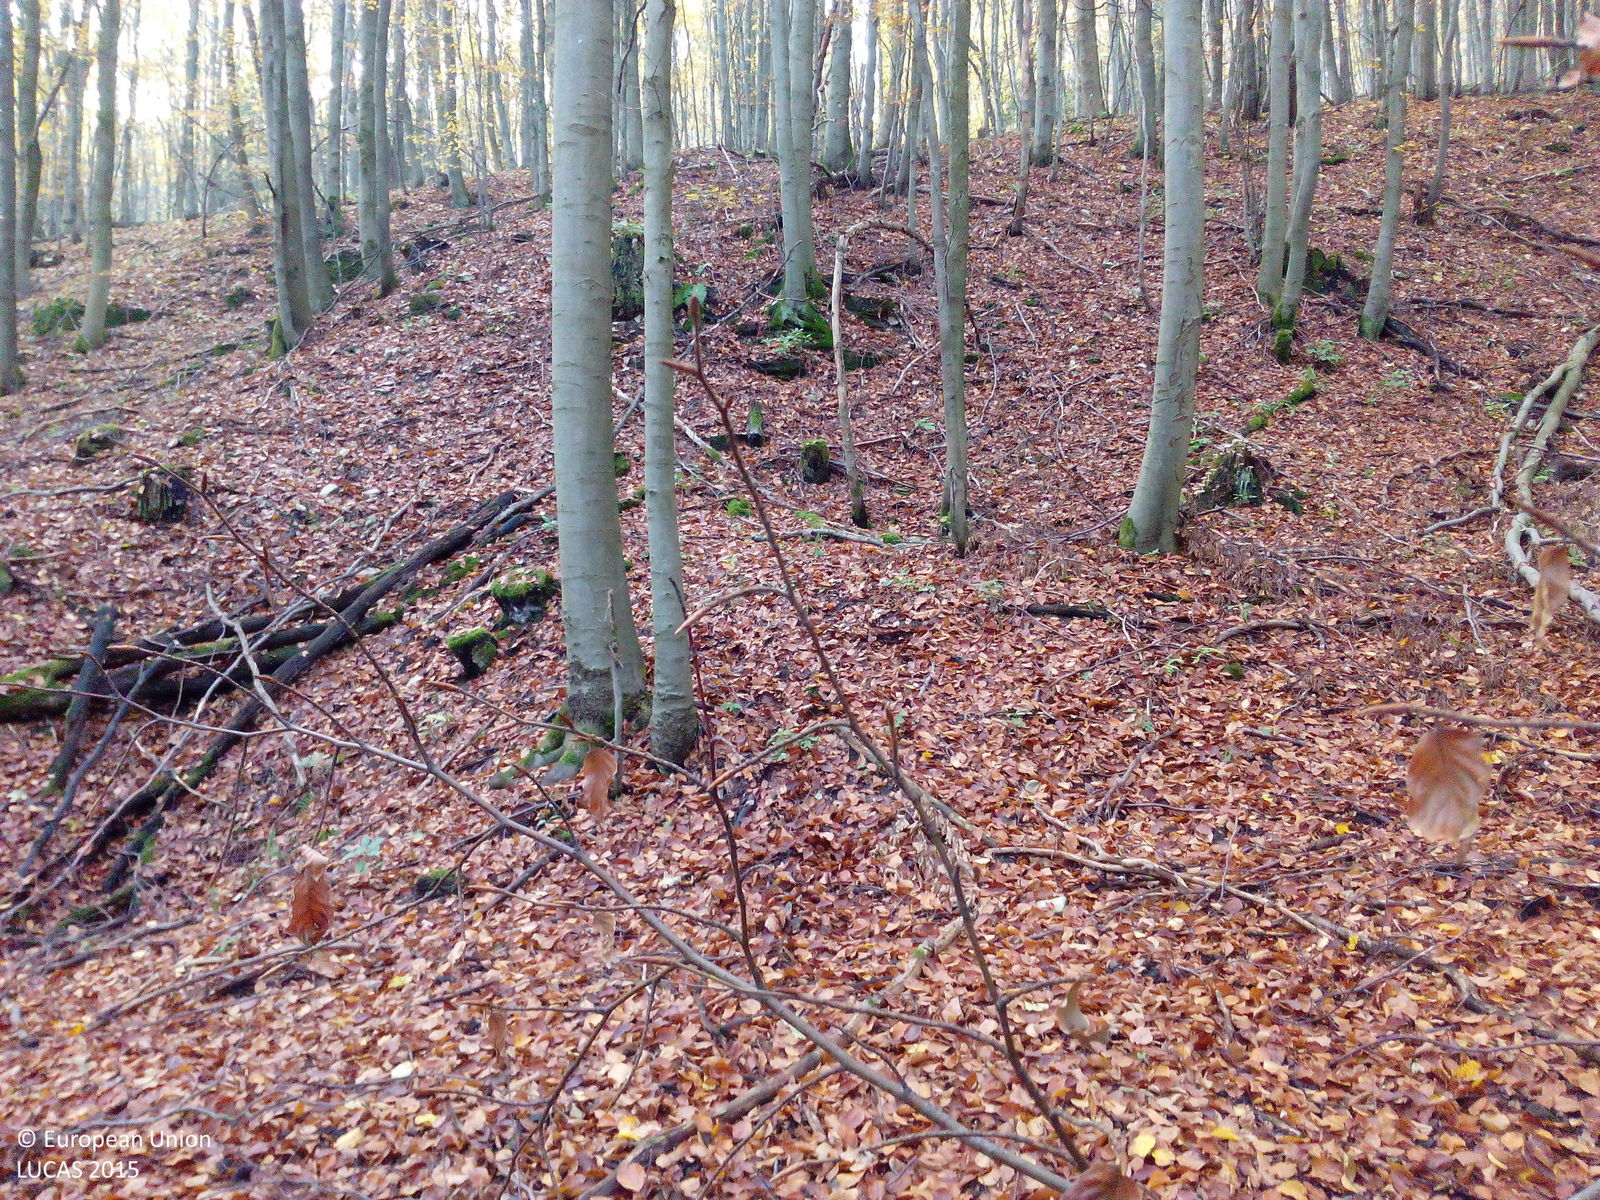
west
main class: Woodland
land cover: Broadleaved woodland
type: mesophytic deciduous forest
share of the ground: > 75 %
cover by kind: broadleaved forest trees 75 %, unconsolidated bare surface 20 %, herbaceous plants 5 %
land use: Forestry
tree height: > 5 m
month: October
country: DE
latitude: 50.3101
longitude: 9.9298
